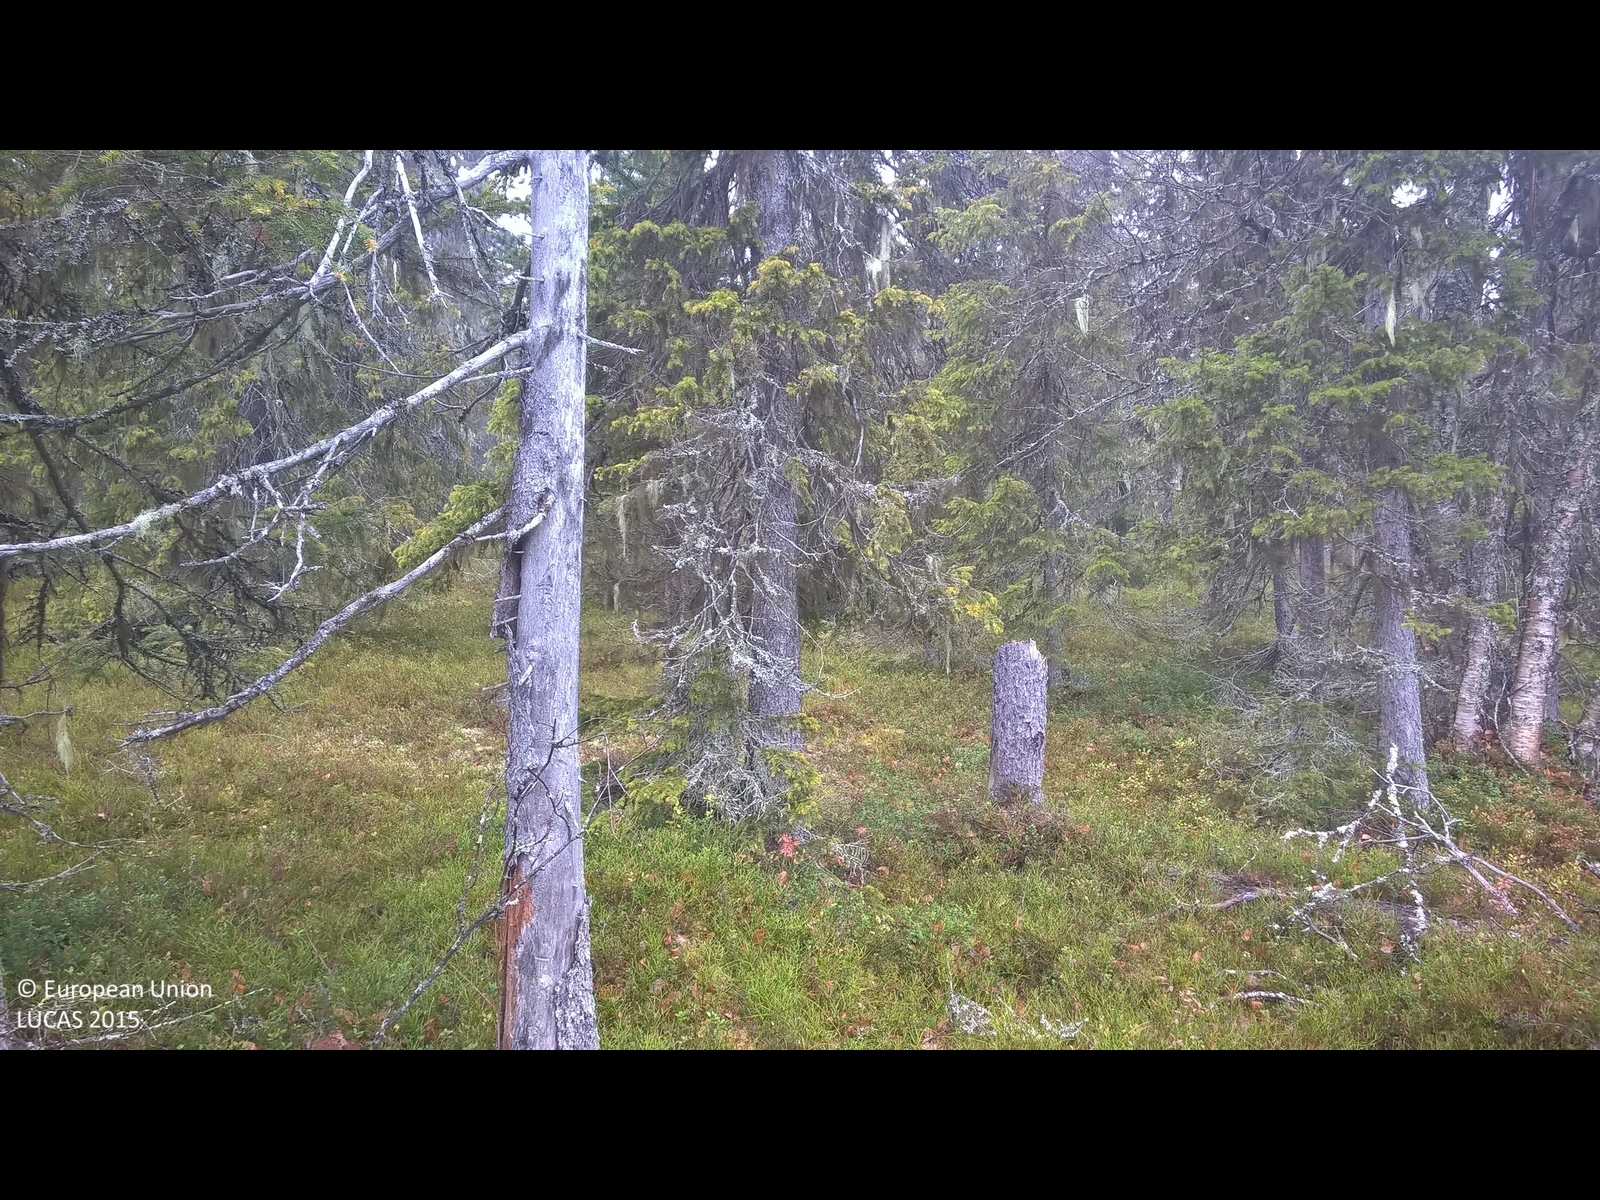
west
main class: Woodland
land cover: Spruce dominated coniferous woodland
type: boreal forest
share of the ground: > 75 %
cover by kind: coniferous forest trees 80 %, shrubs 15 %, lichens and mosses 5 %
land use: Forestry
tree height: > 5 m
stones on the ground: < 10 %
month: October
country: SE
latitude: 65.6458
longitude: 18.8044
